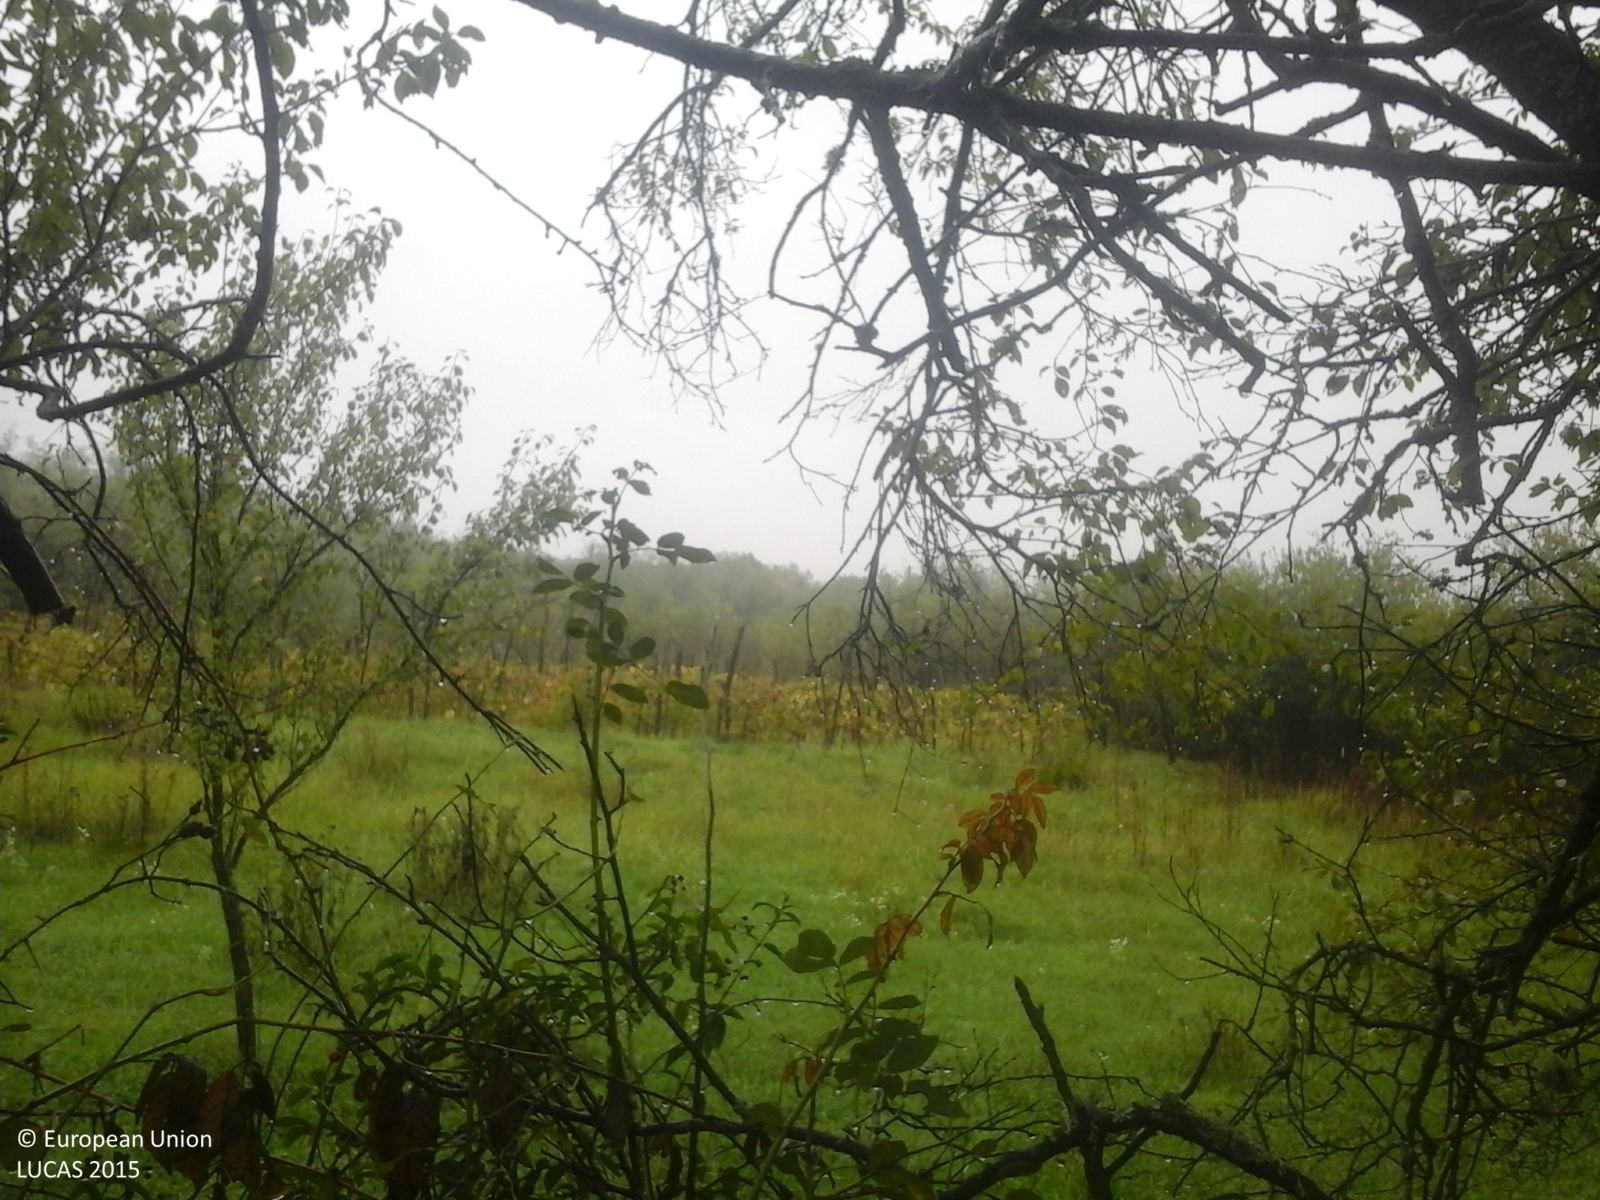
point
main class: Cropland
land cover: Vineyards
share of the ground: > 75 %
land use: Agriculture (excluding fallow land and kitchen gardens)
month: September
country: RO
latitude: 44.8332
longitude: 23.5022
